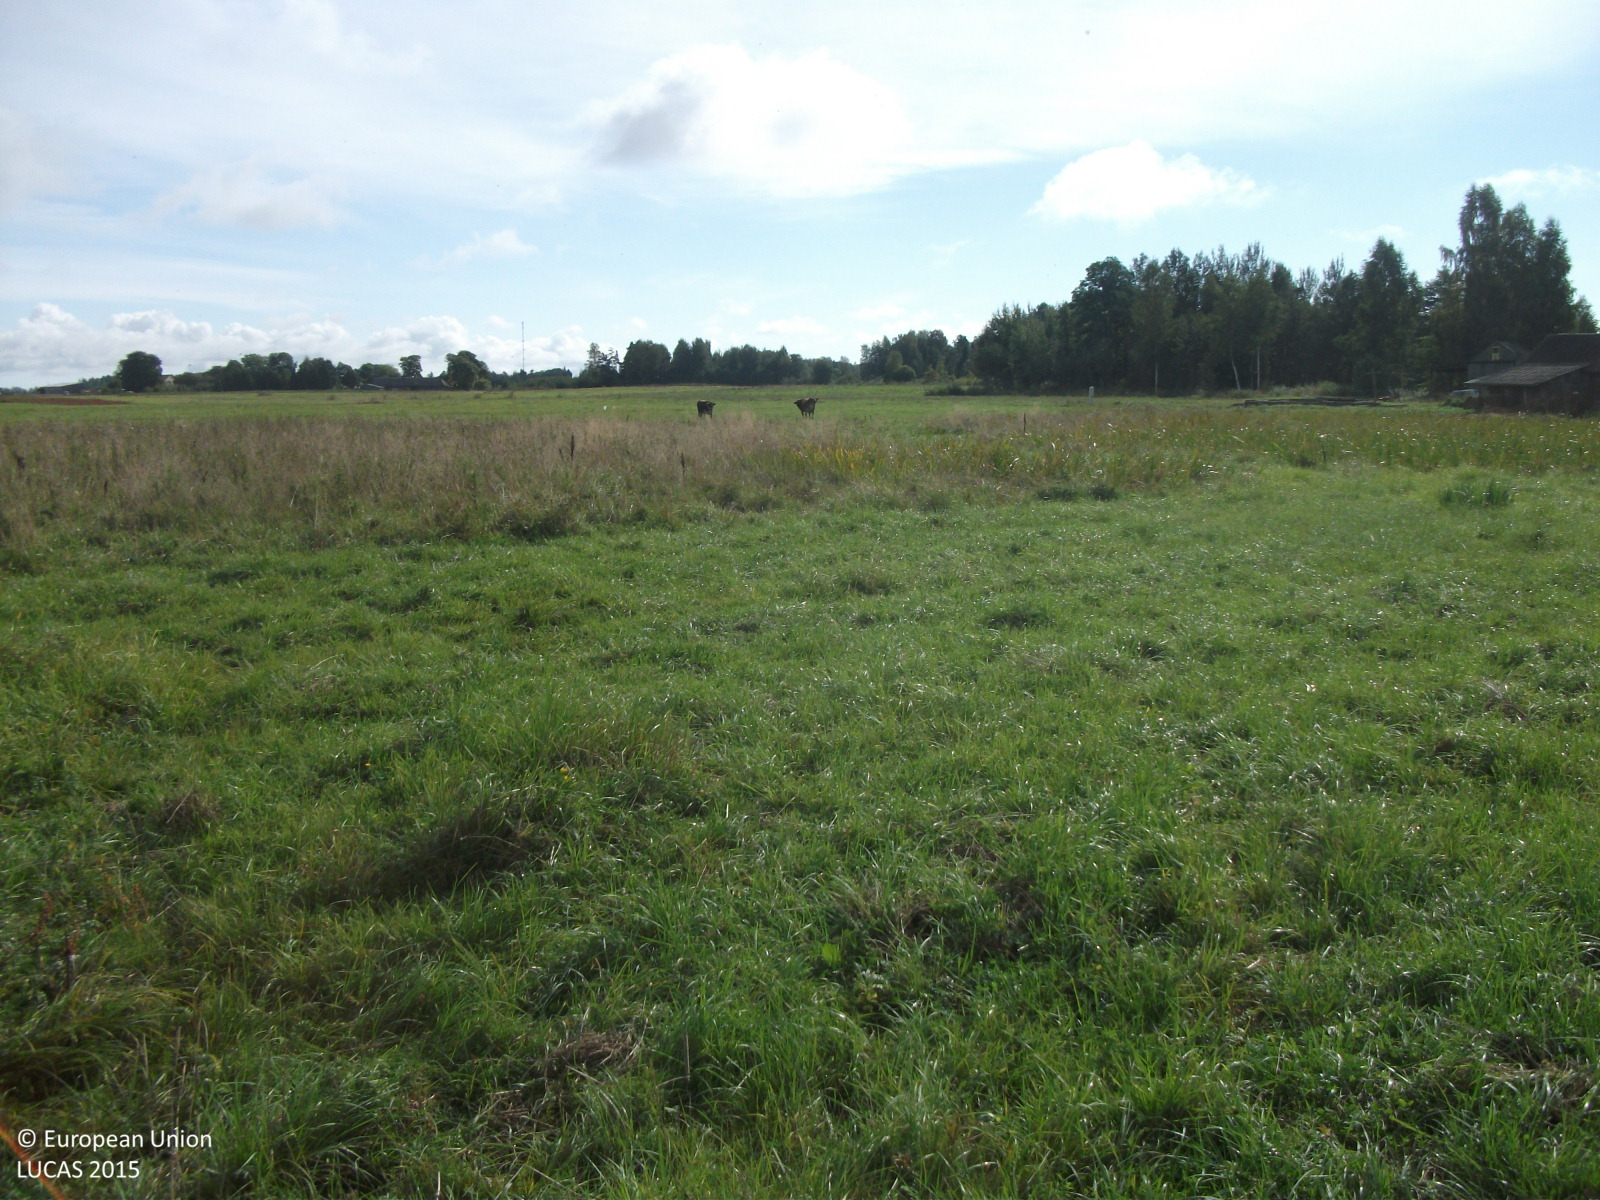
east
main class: Grassland
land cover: Grassland without tree/shrub cover
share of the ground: > 75 %
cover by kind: herbaceous plants 100 %
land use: Agriculture (excluding fallow land and kitchen gardens)
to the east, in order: Grassland without tree/shrub cover; Fences; Grassland without tree/shrub cover; Electric lines; Grassland without tree/shrub cover; Tracks
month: September
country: LV
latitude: 56.5425
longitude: 26.2243
